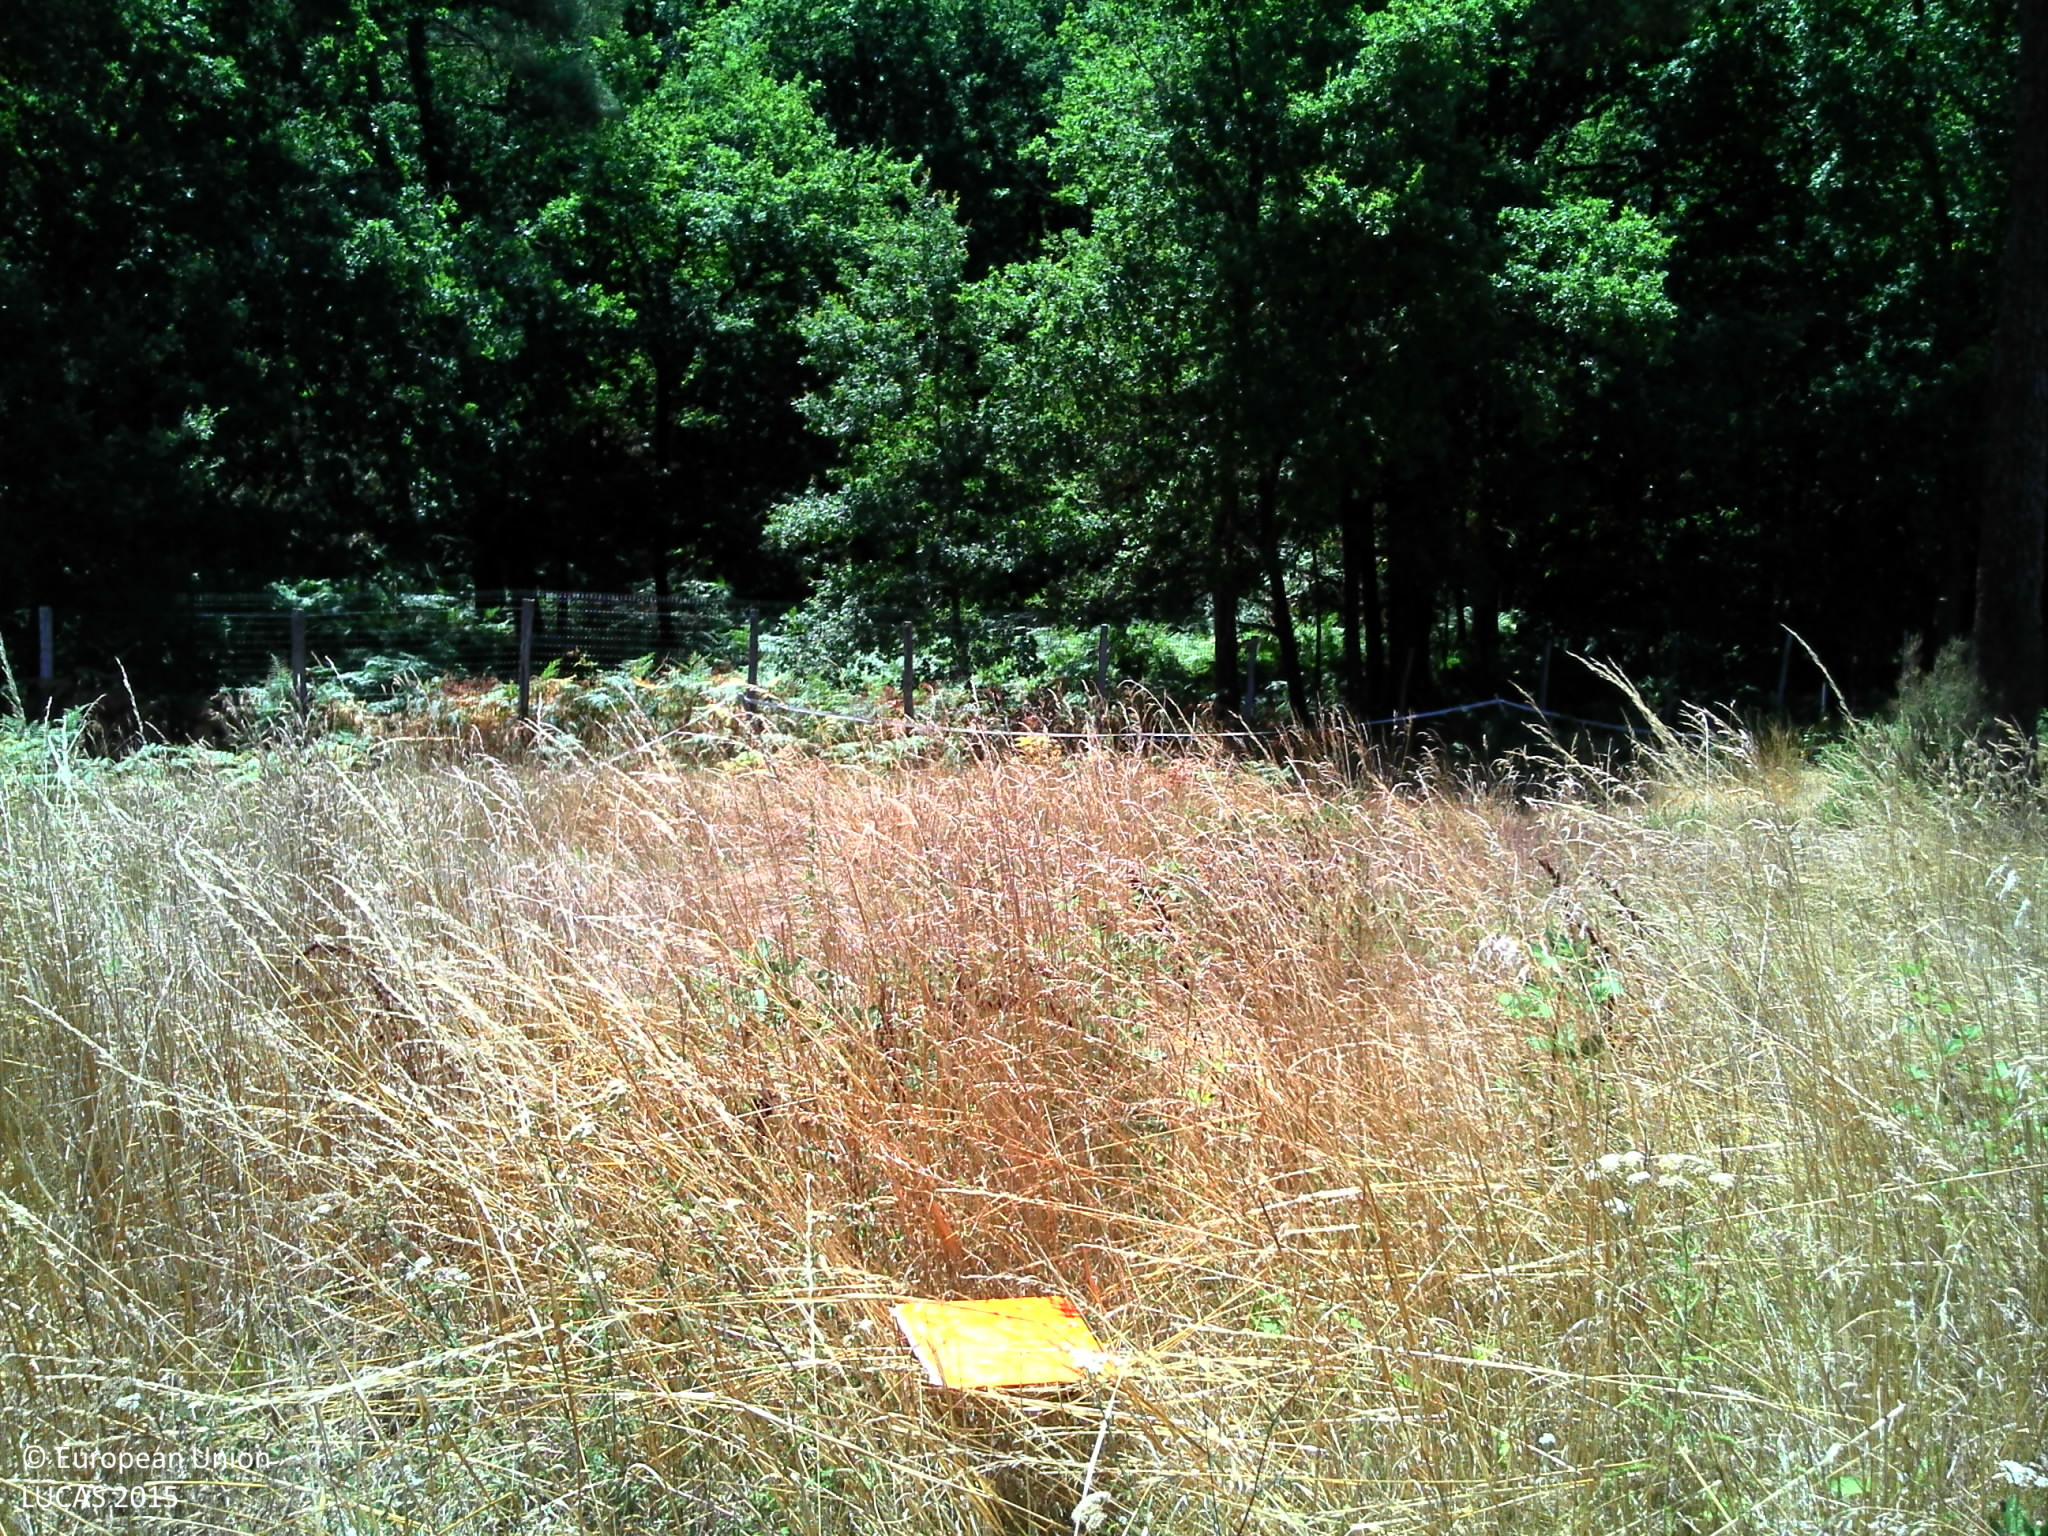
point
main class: Grassland
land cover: Grassland with sparse tree/shrub cover
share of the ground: > 75 %
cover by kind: herbaceous plants 95 %, broadleaved forest trees 5 %
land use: Agriculture (excluding fallow land and kitchen gardens)
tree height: < 5 m
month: July
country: FR
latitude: 44.8095
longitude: 0.5712
